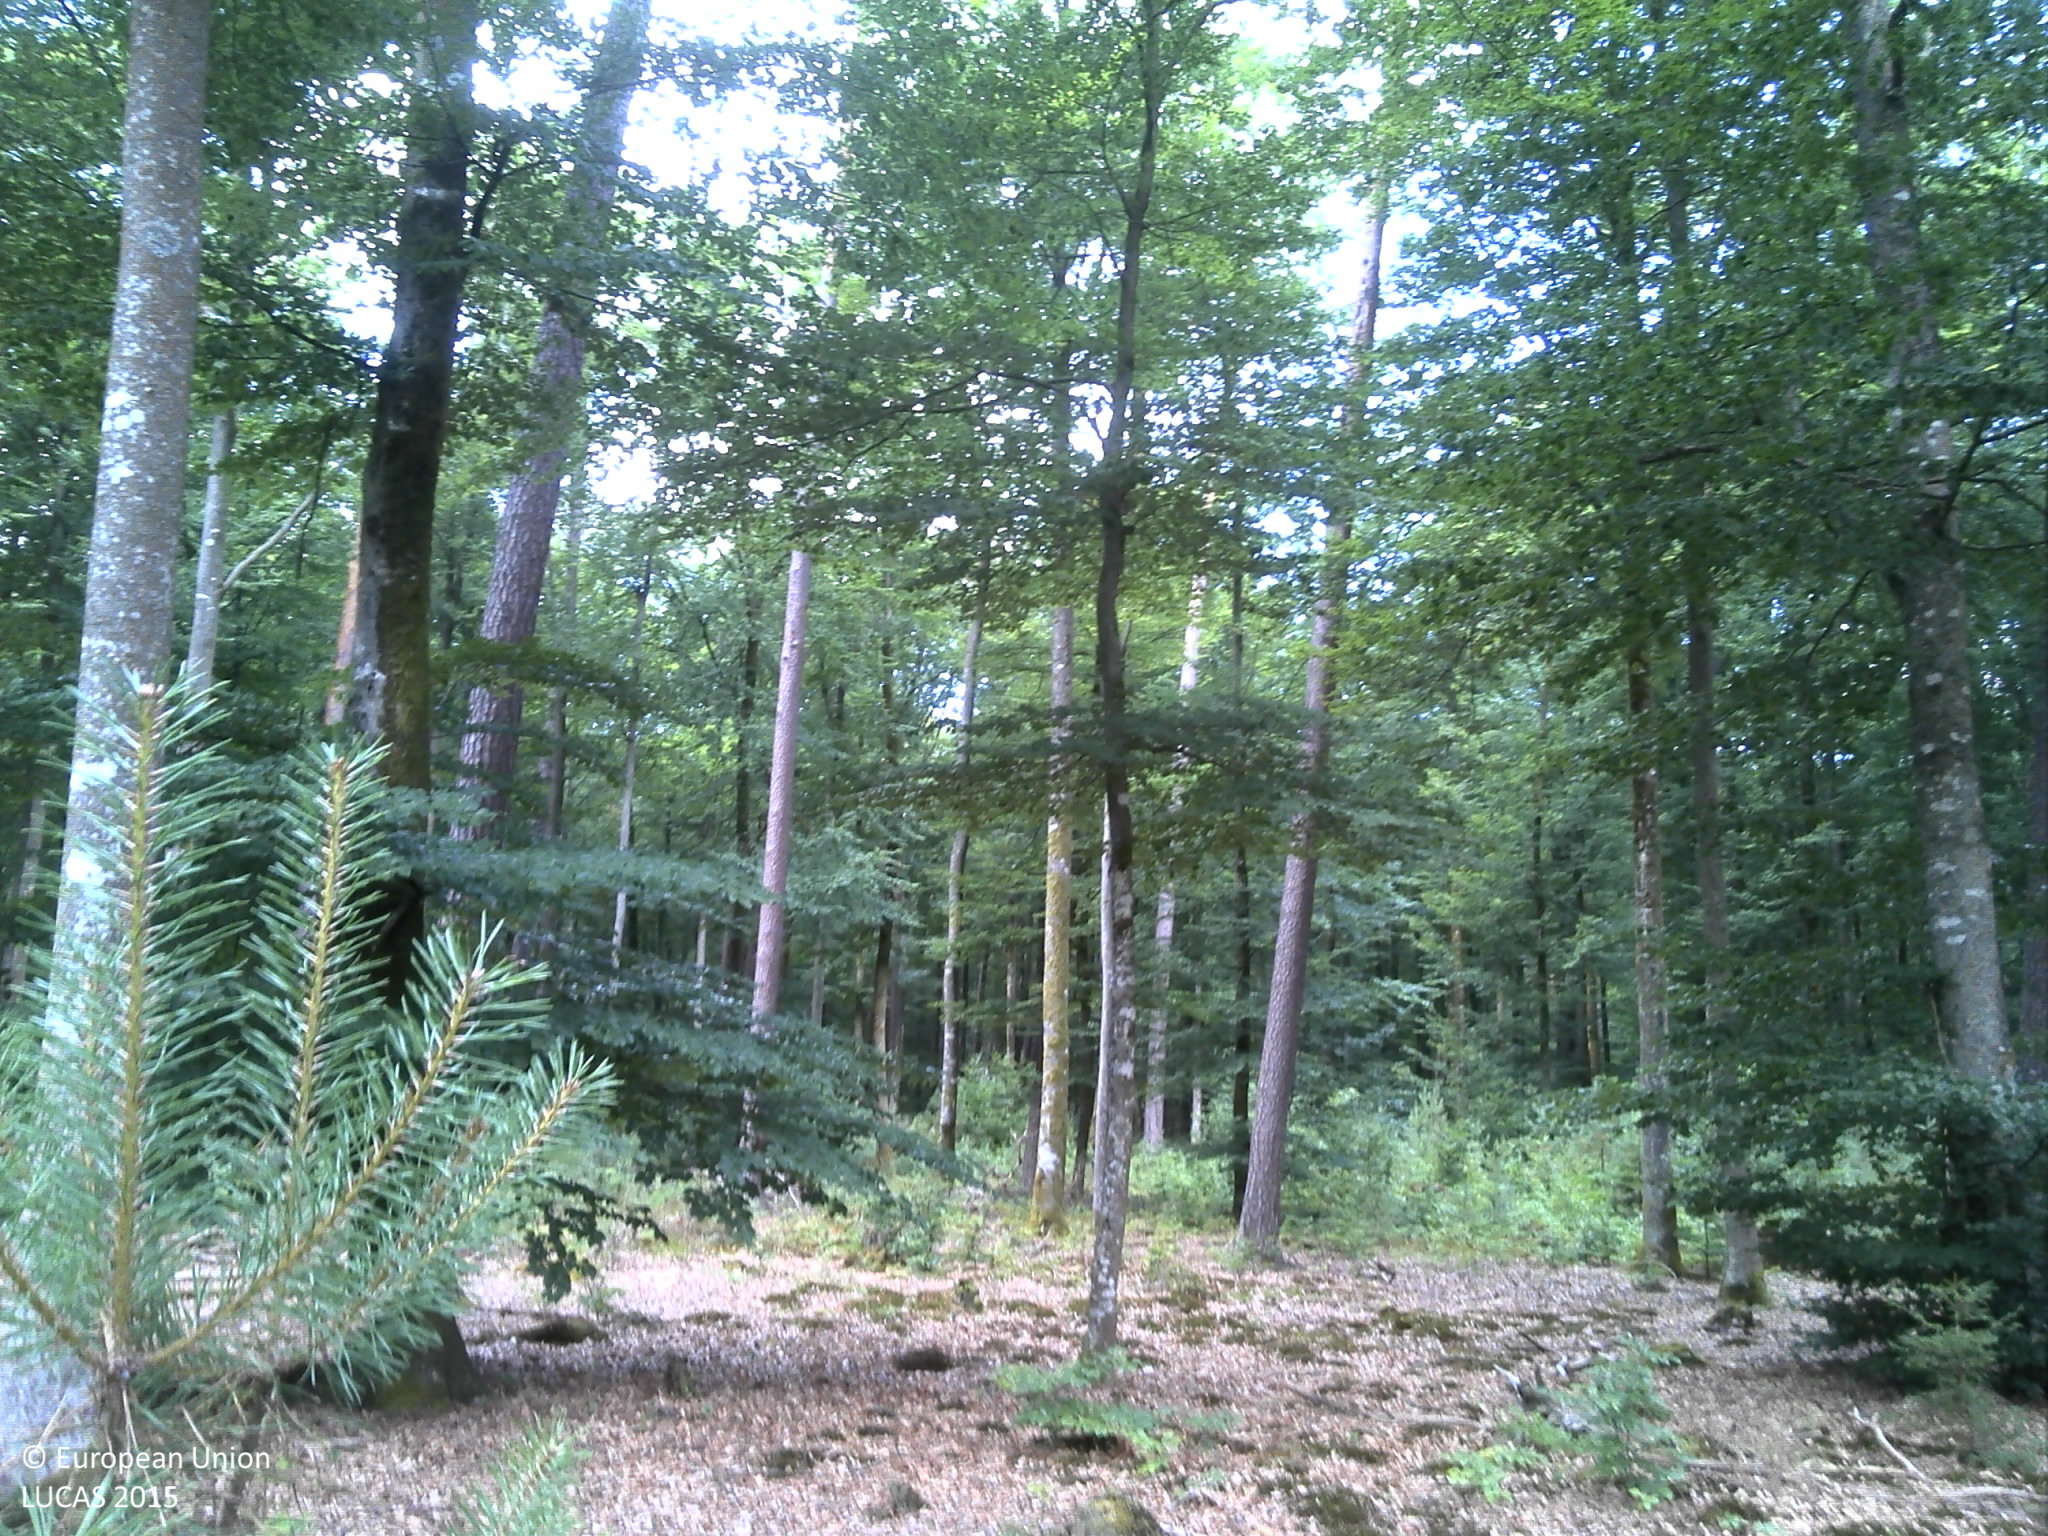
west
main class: Woodland
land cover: Pine dominated mixed woodland
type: hemiboreal forest and nemoral coniferous forest and mixed broadleaved-coniferous forest
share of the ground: > 75 %
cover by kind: coniferous forest trees 40 %, broadleaved forest trees 40 %, unconsolidated bare surface 10 %, herbaceous plants 5 %, lichens and mosses 5 %
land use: Forestry
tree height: > 5 m
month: July
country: FR
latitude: 49.0441
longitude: 7.6338
